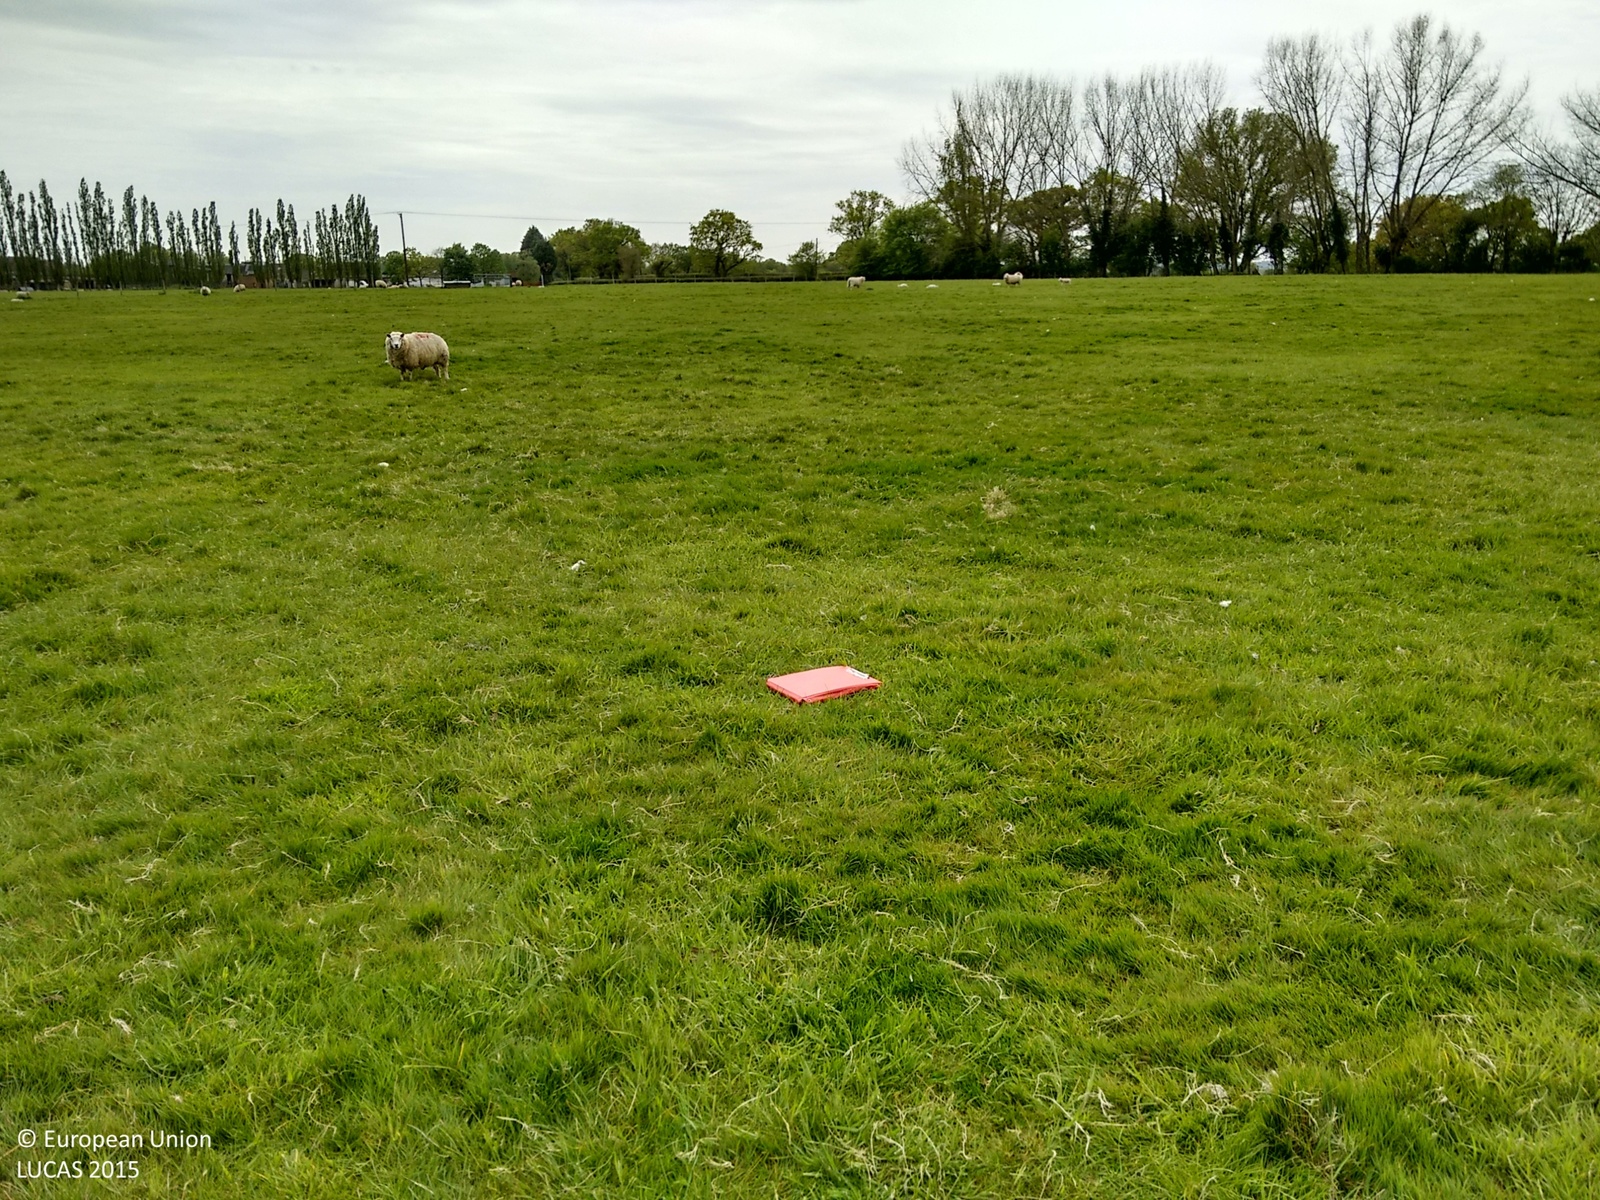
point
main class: Grassland
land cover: Grassland without tree/shrub cover
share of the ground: > 75 %
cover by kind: herbaceous plants 100 %
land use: Agriculture (excluding fallow land and kitchen gardens)
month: May
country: GB
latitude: 51.2047
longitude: 0.5692
